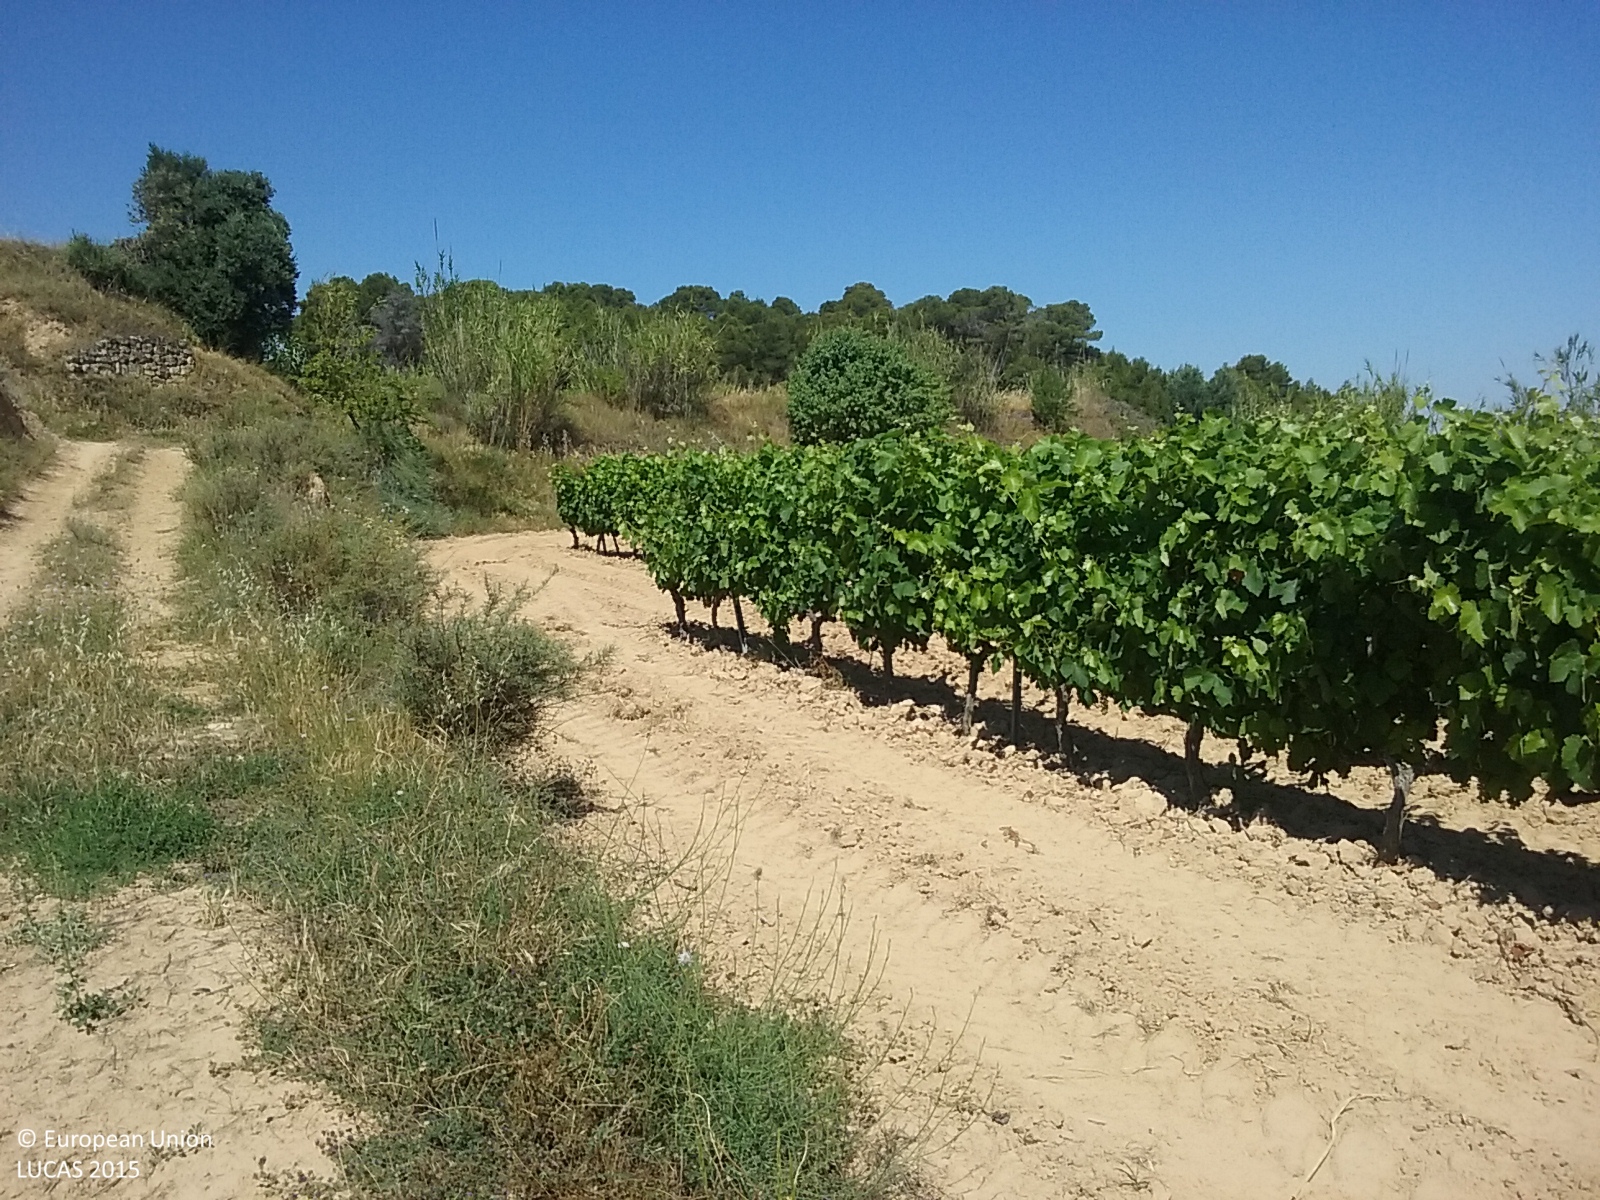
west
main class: Cropland
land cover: Vineyards
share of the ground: 10 - 25 %
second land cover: Other bare soil
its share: > 75 %
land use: Agriculture (excluding fallow land and kitchen gardens)
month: June
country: ES
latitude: 41.0794
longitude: 0.3137
